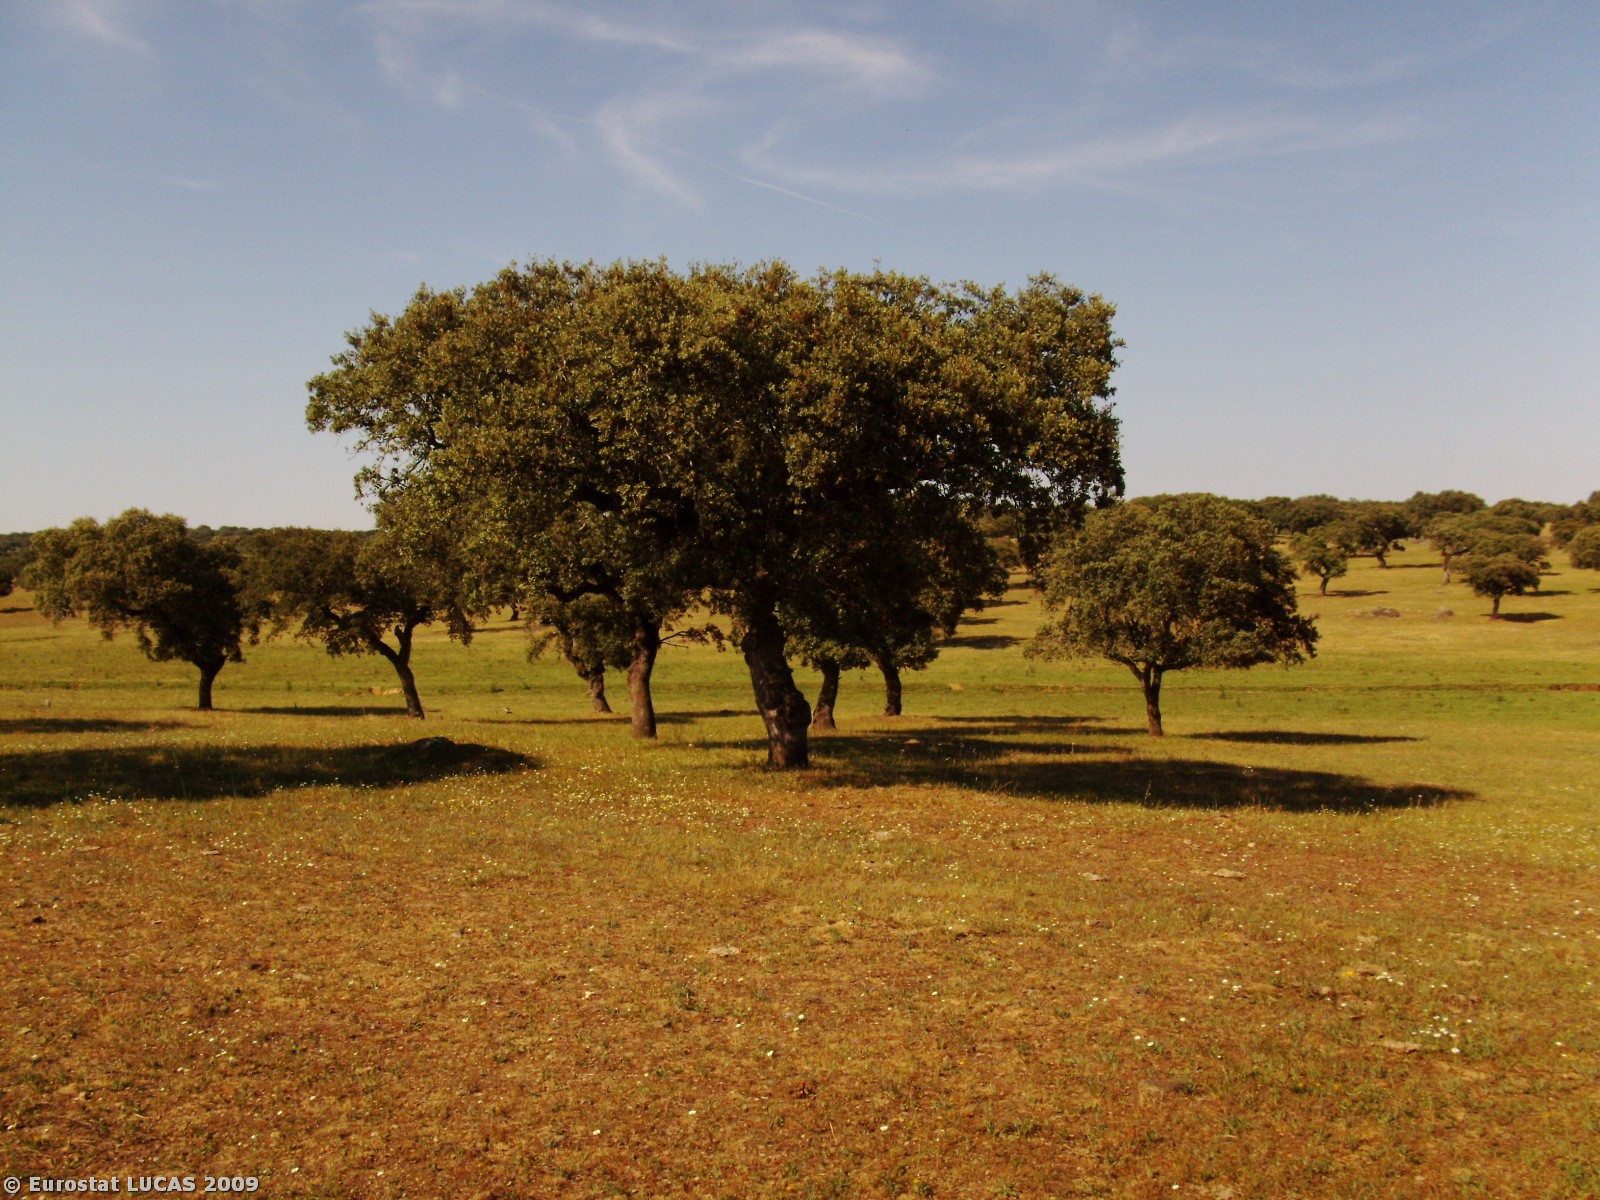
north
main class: Woodland
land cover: Broadleaved woodland
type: broadleaved evergreen forest
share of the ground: 25 - 50 %
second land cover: Spontaneously vegetated surfaces
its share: 50 - 75 %
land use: Agriculture (excluding fallow land and kitchen gardens)
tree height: > 5 m
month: May
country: PT
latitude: 38.8028
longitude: -7.3372
